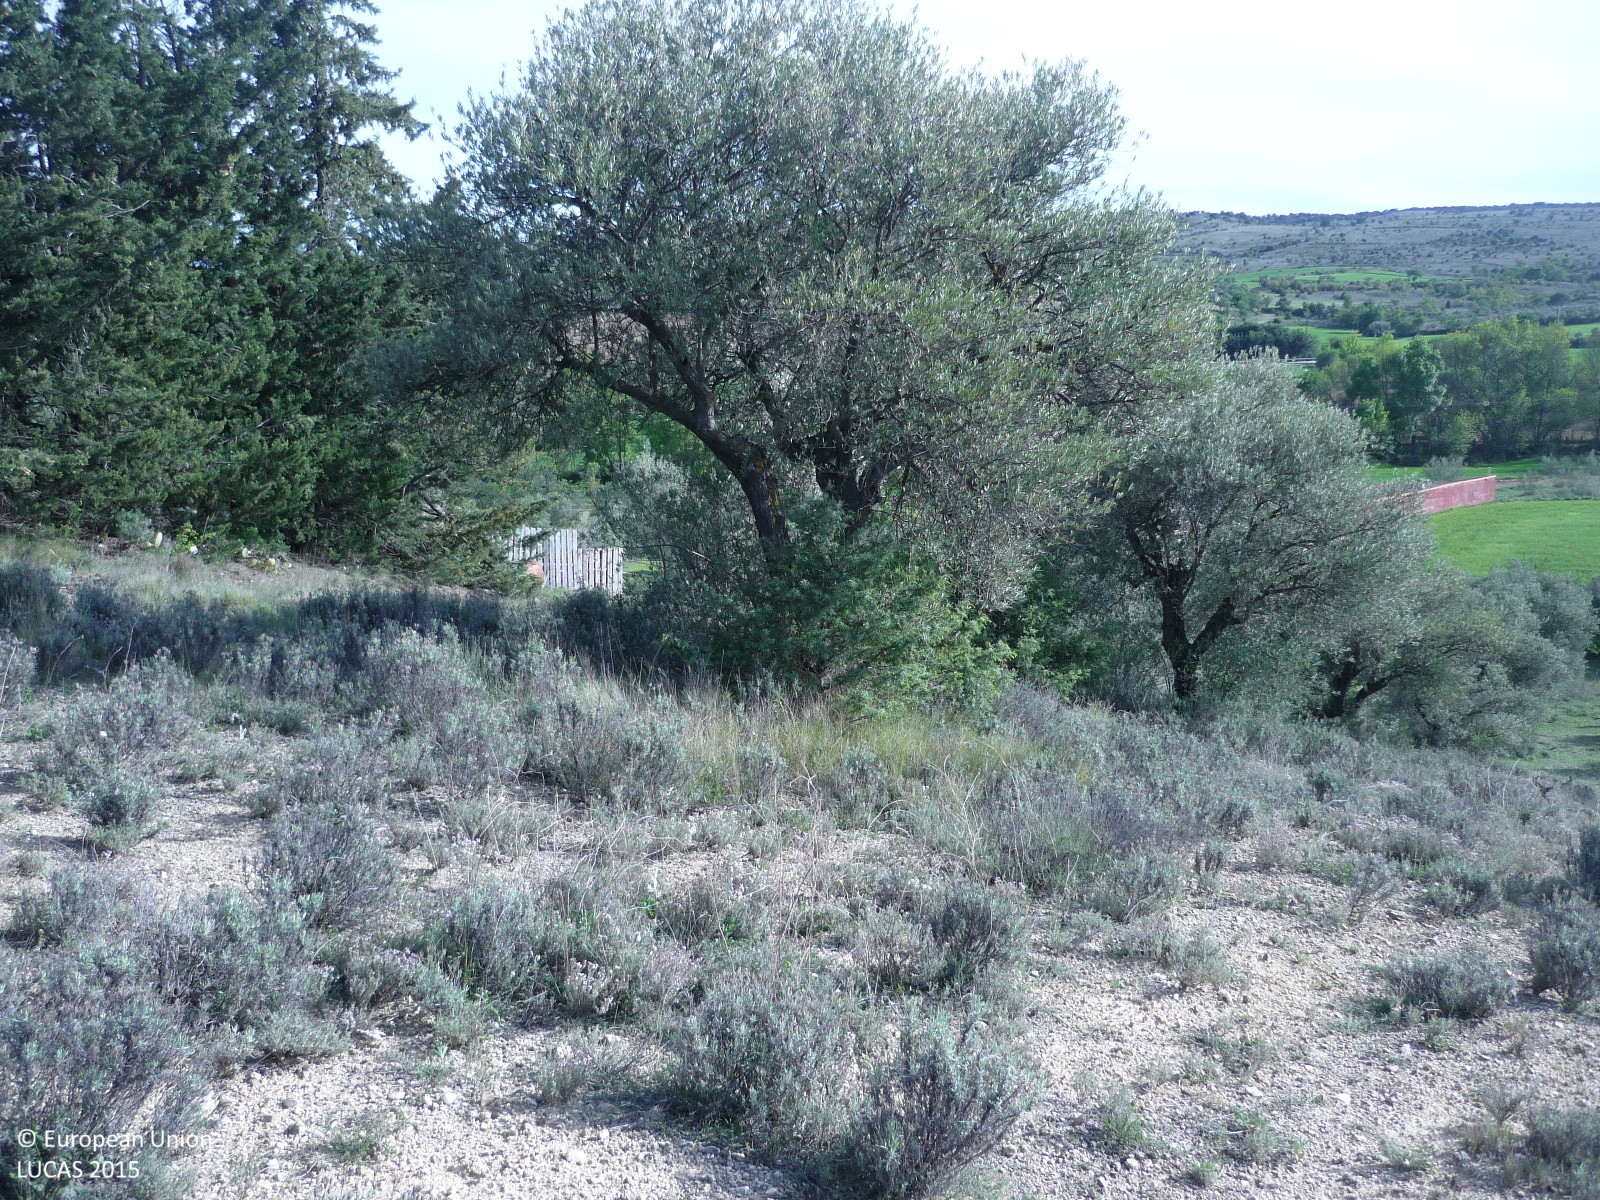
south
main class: Cropland
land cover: Olive groves
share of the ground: 25 - 50 %
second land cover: Shrubland without tree cover
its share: 50 - 75 %
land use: Abandoned areas
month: April
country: ES
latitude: 40.8214
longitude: -3.5692
